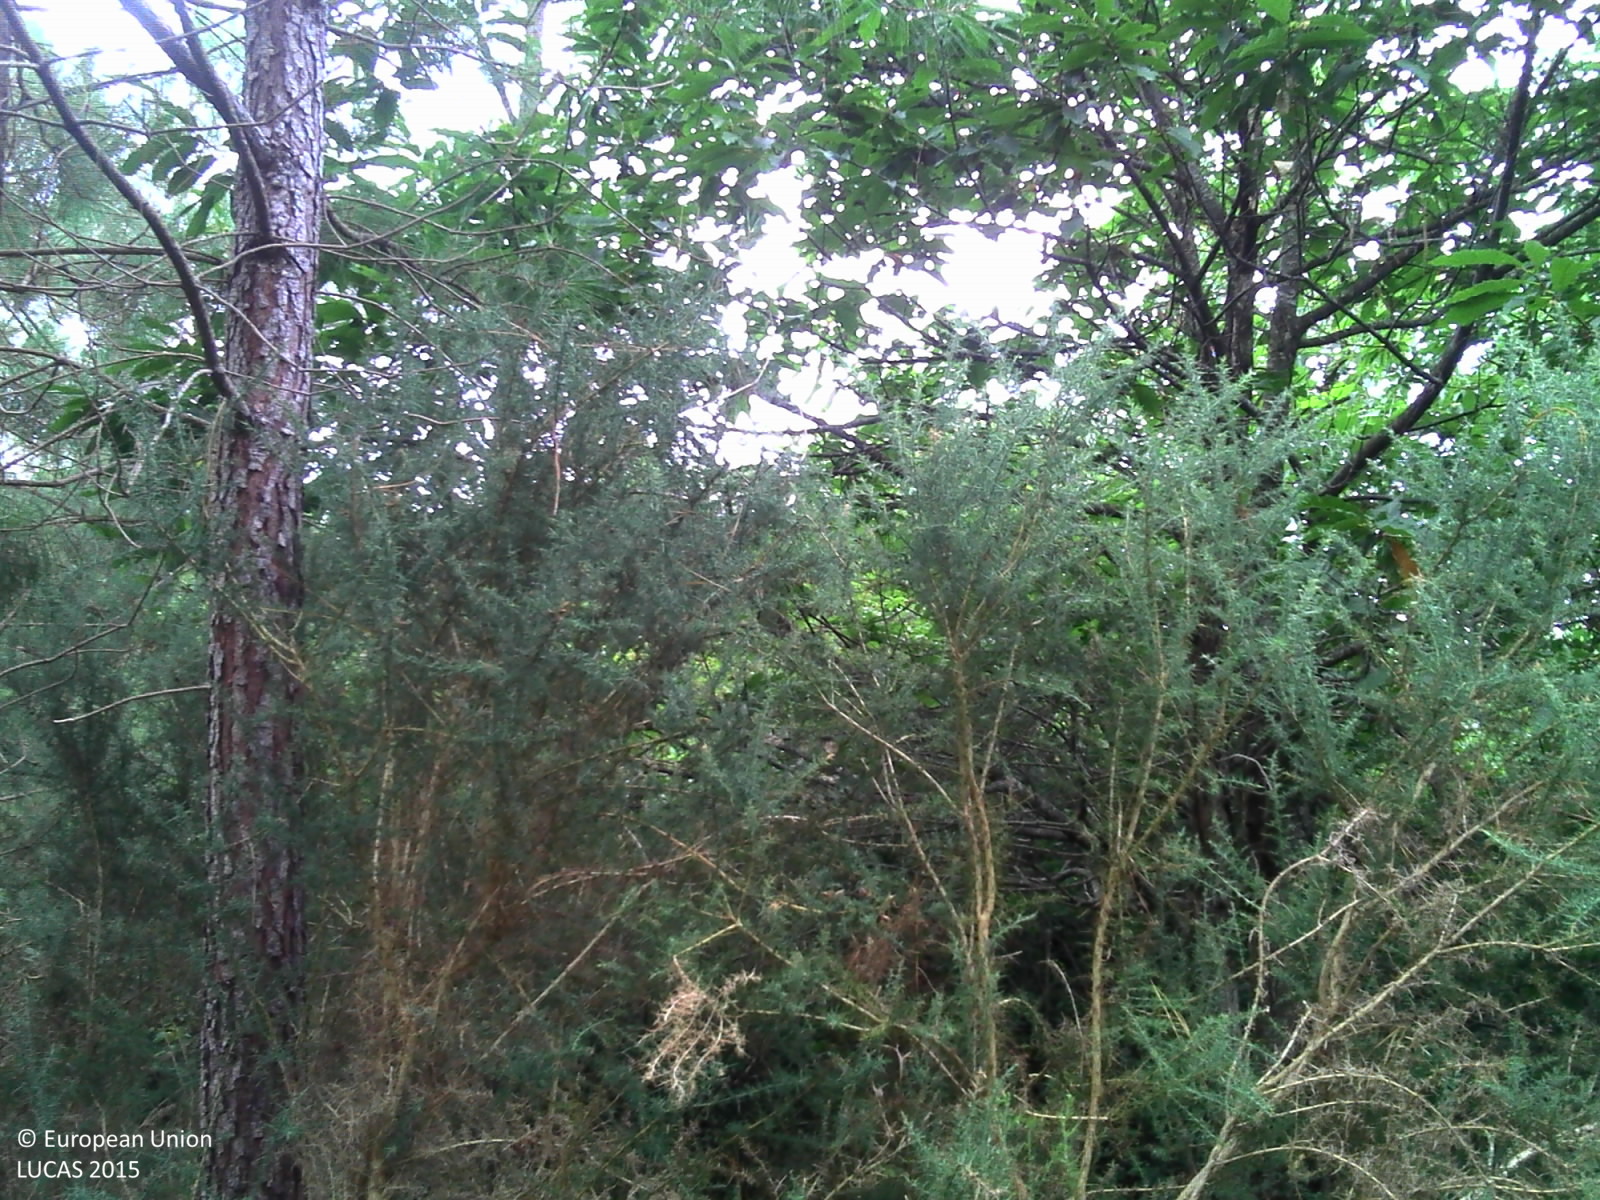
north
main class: Woodland
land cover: Pine dominated coniferous woodland
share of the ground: > 75 %
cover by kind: coniferous forest trees 85 %, herbaceous plants 10 %, broadleaved forest trees 5 %
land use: Forestry
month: July
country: FR
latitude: 43.5911
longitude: -1.2510
